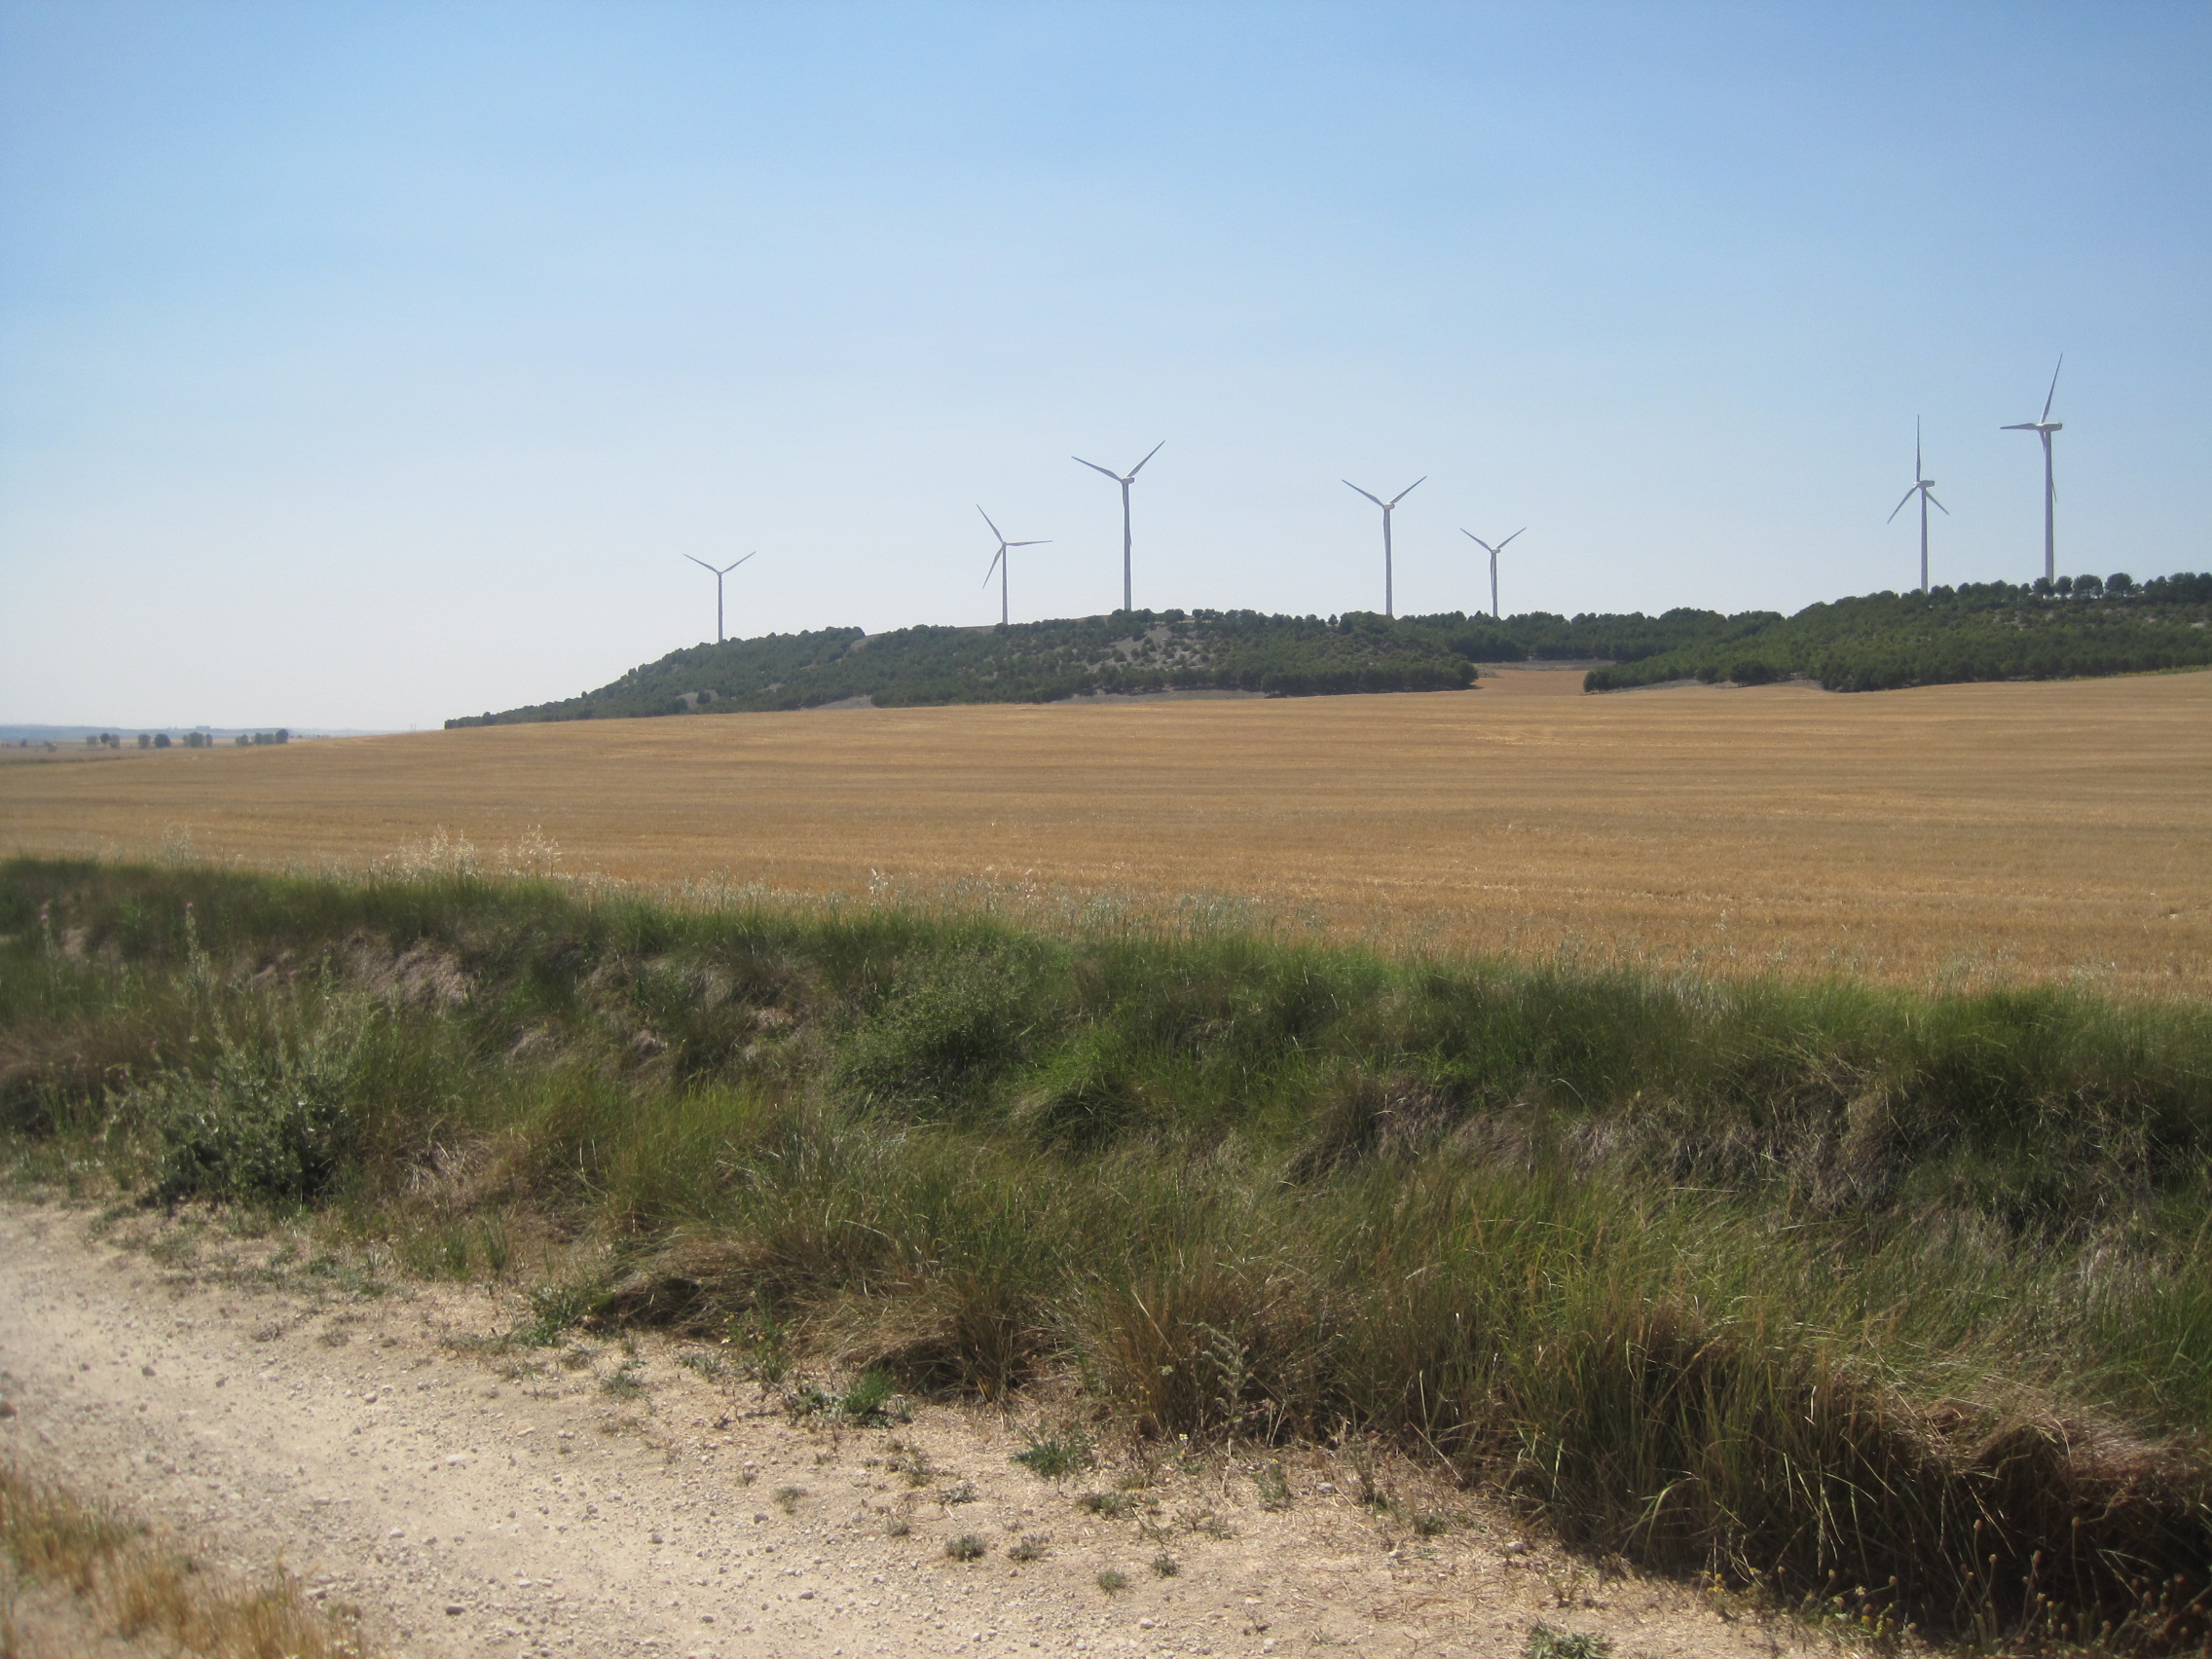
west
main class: Cropland
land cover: Common wheat
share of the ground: < 10 %
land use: Agriculture (excluding fallow land and kitchen gardens)
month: July
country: ES
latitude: 41.9338
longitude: -4.7505
